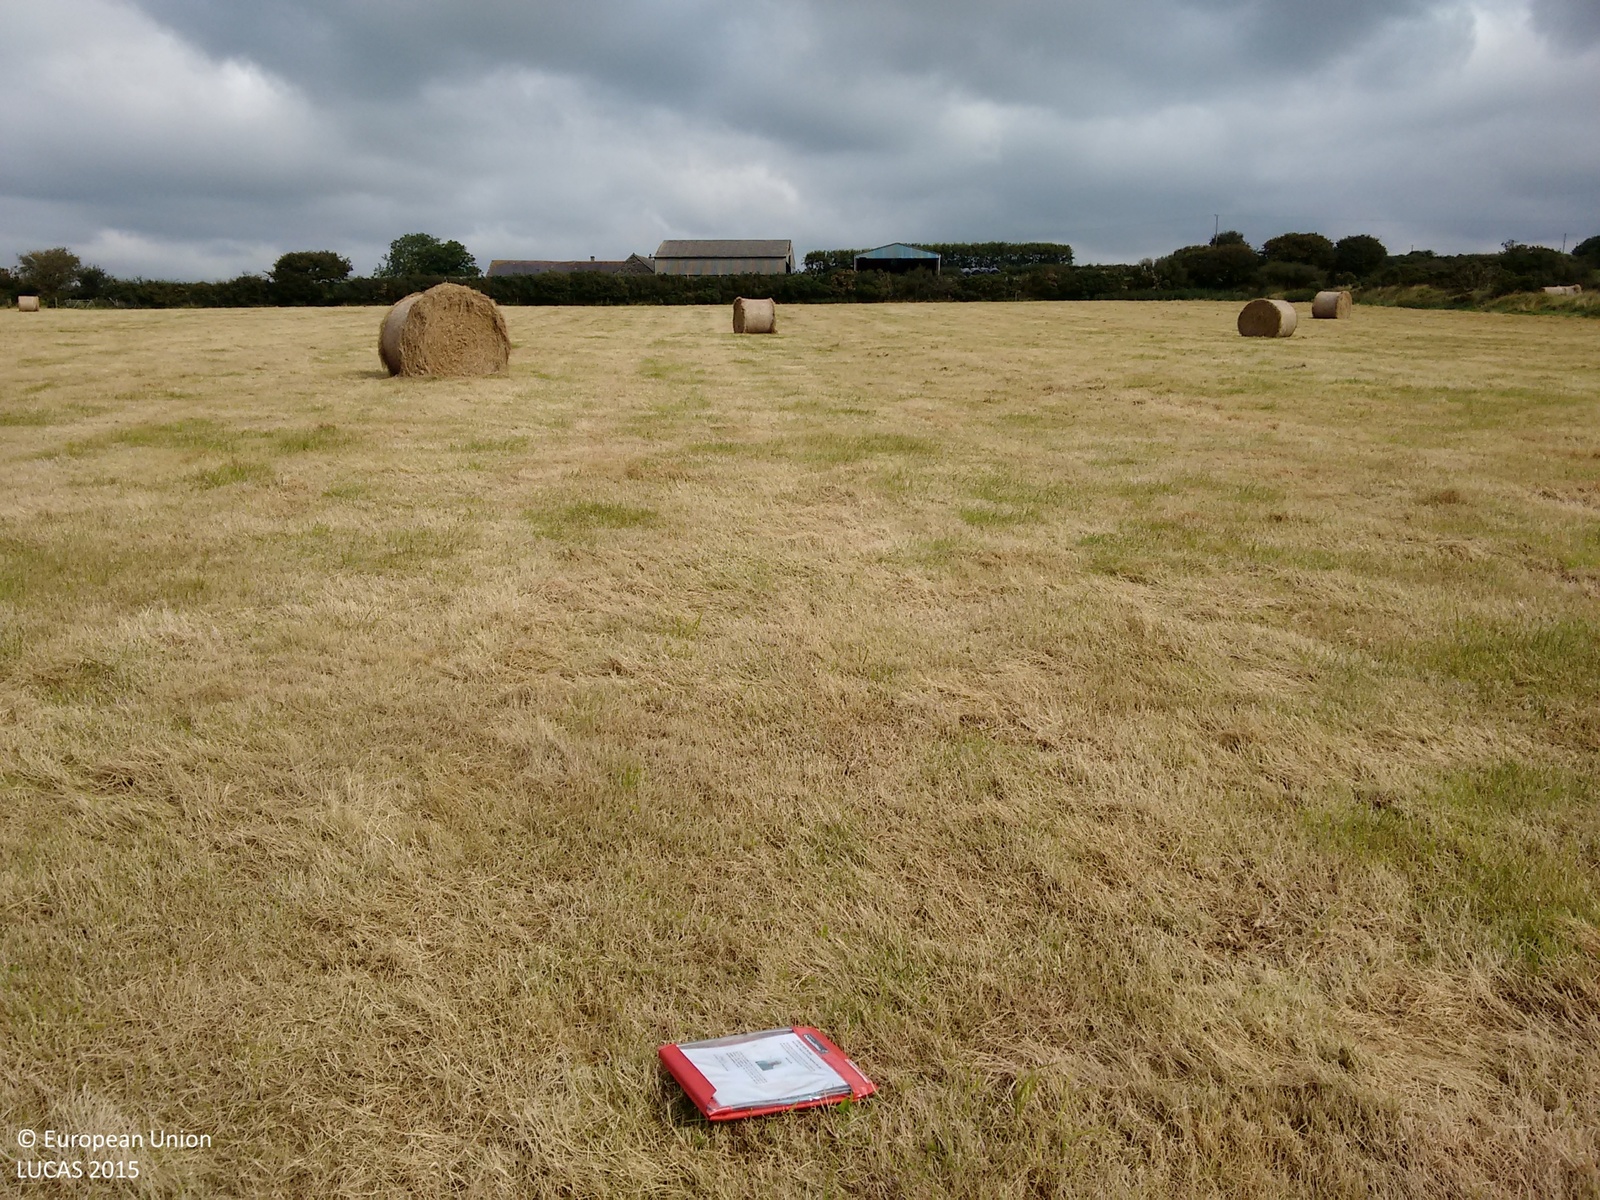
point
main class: Grassland
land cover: Grassland without tree/shrub cover
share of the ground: > 75 %
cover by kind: herbaceous plants 100 %
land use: Agriculture (excluding fallow land and kitchen gardens)
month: September
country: GB
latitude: 52.1251
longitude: -4.4630
